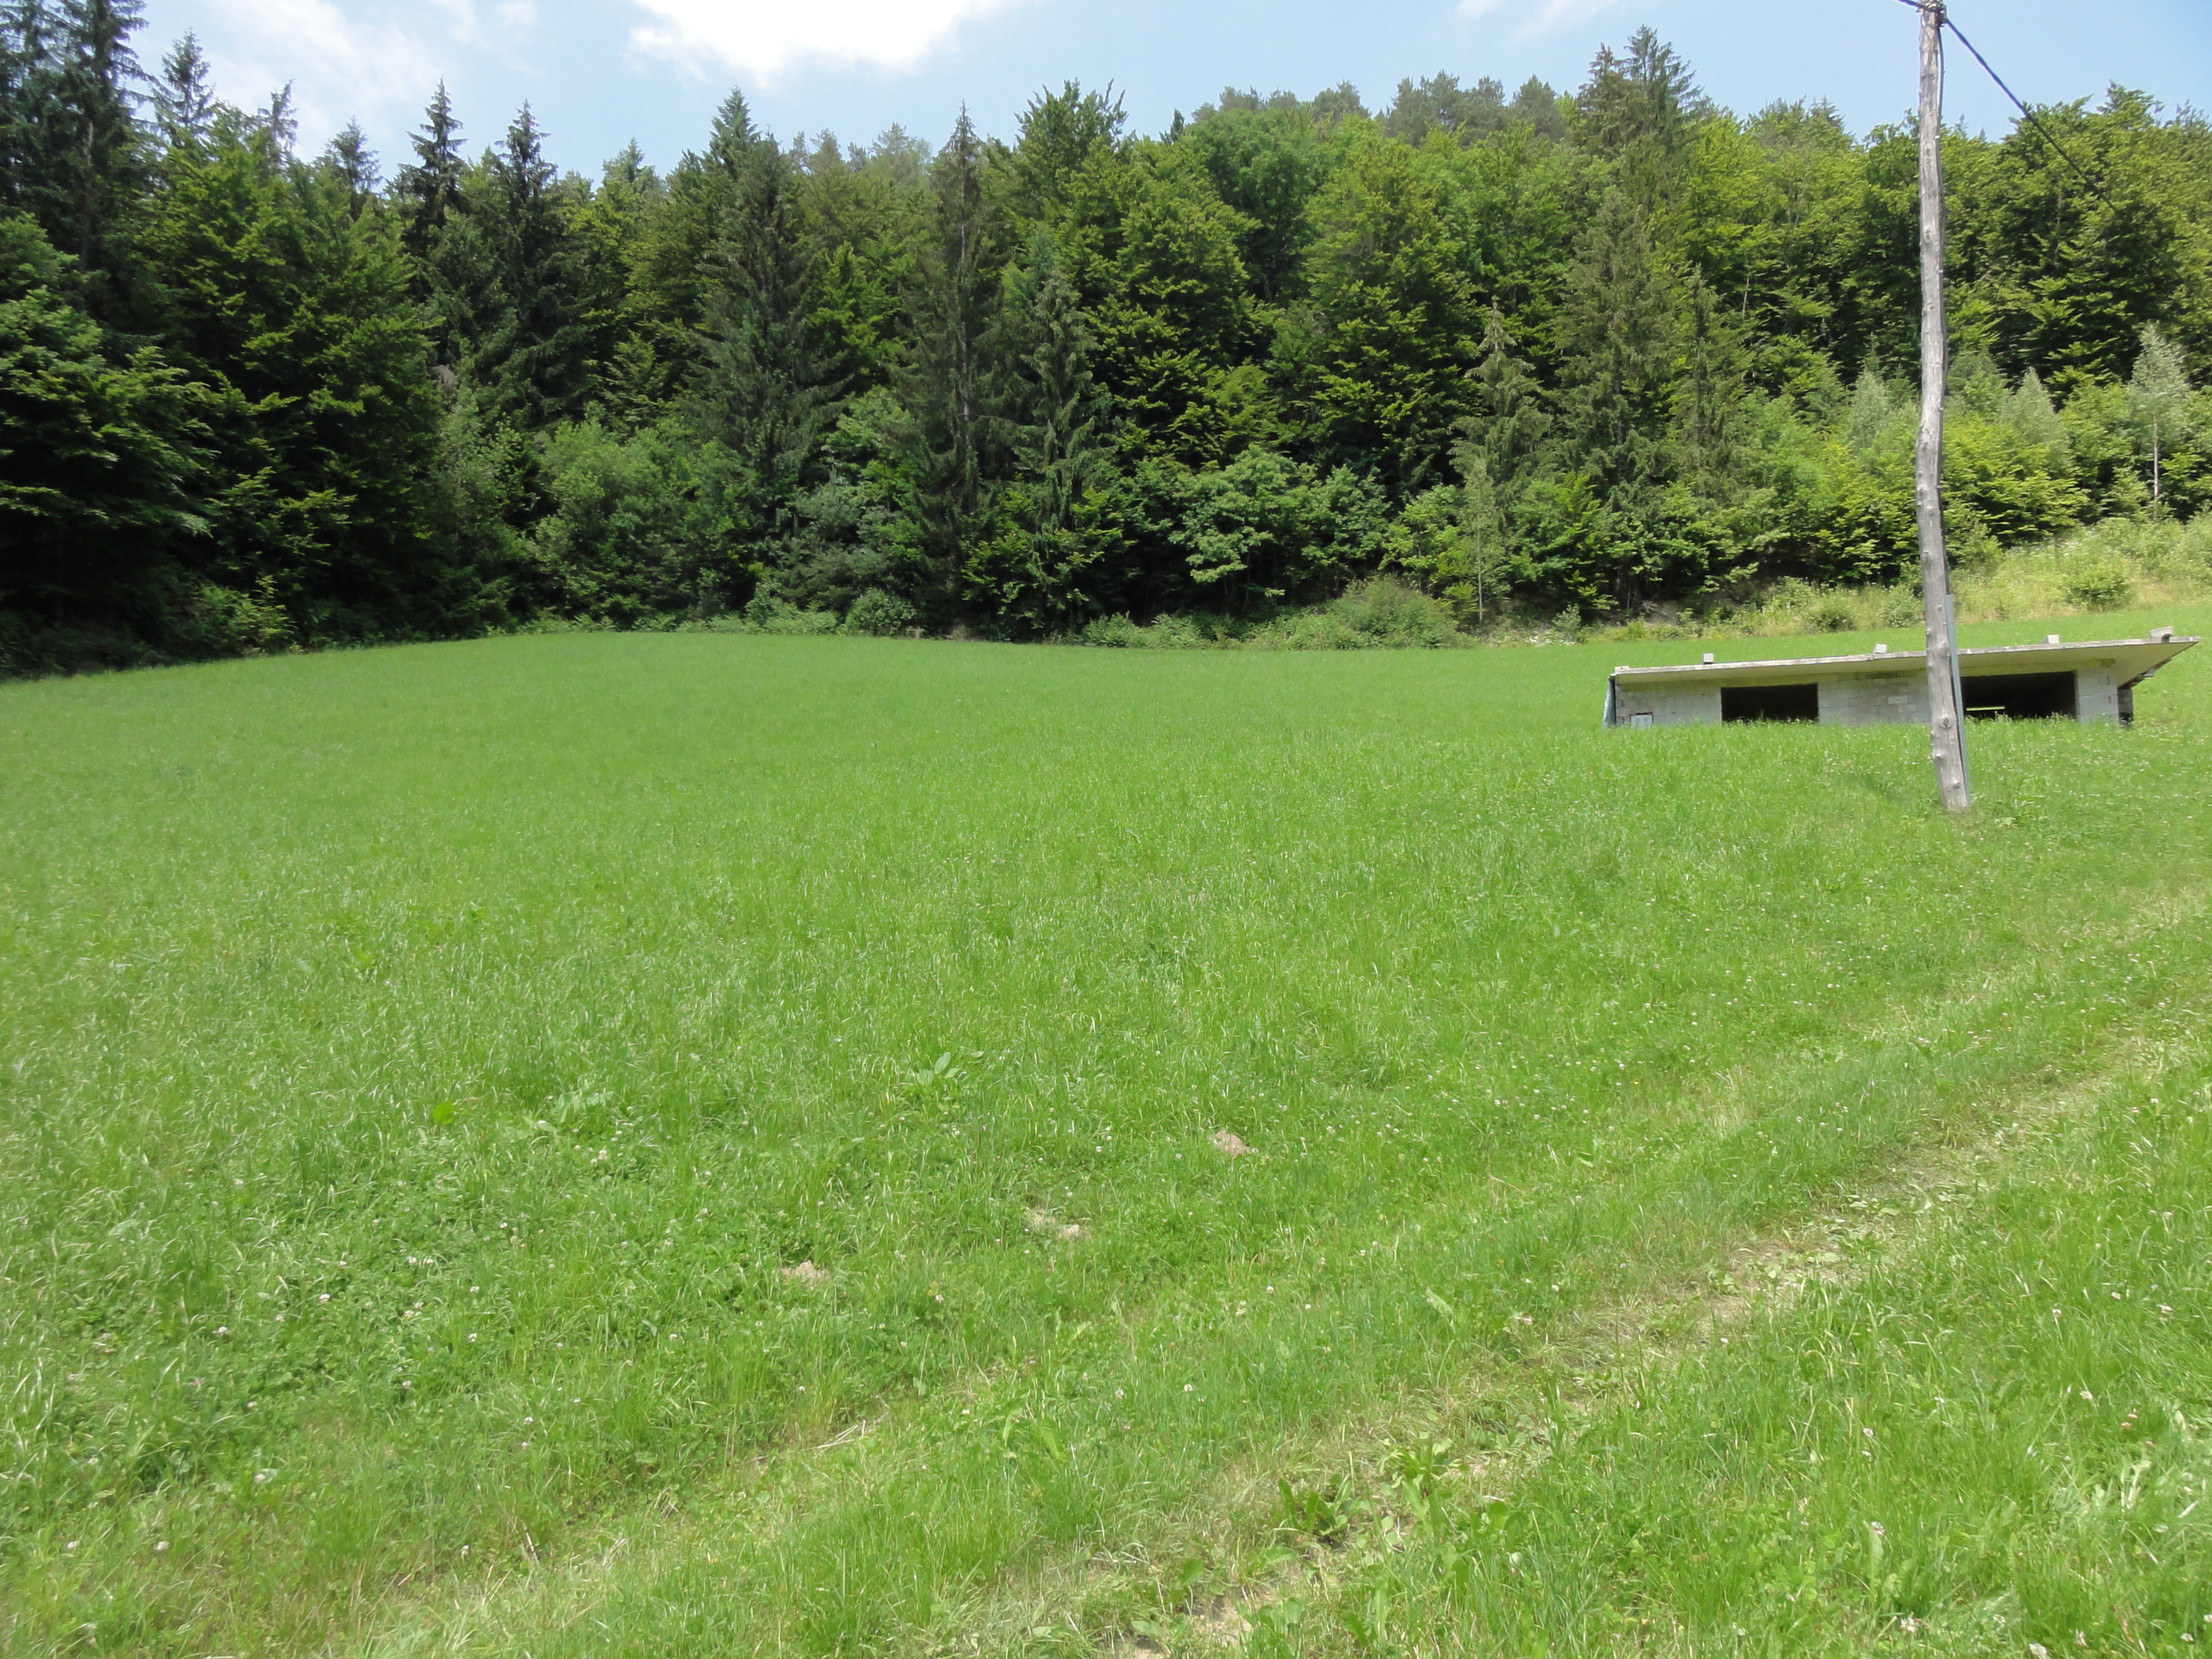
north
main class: Grassland
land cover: Grassland without tree/shrub cover
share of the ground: > 75 %
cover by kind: herbaceous plants 100 %
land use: Agriculture (excluding fallow land and kitchen gardens)
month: June
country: SI
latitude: 46.1685
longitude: 15.2430
